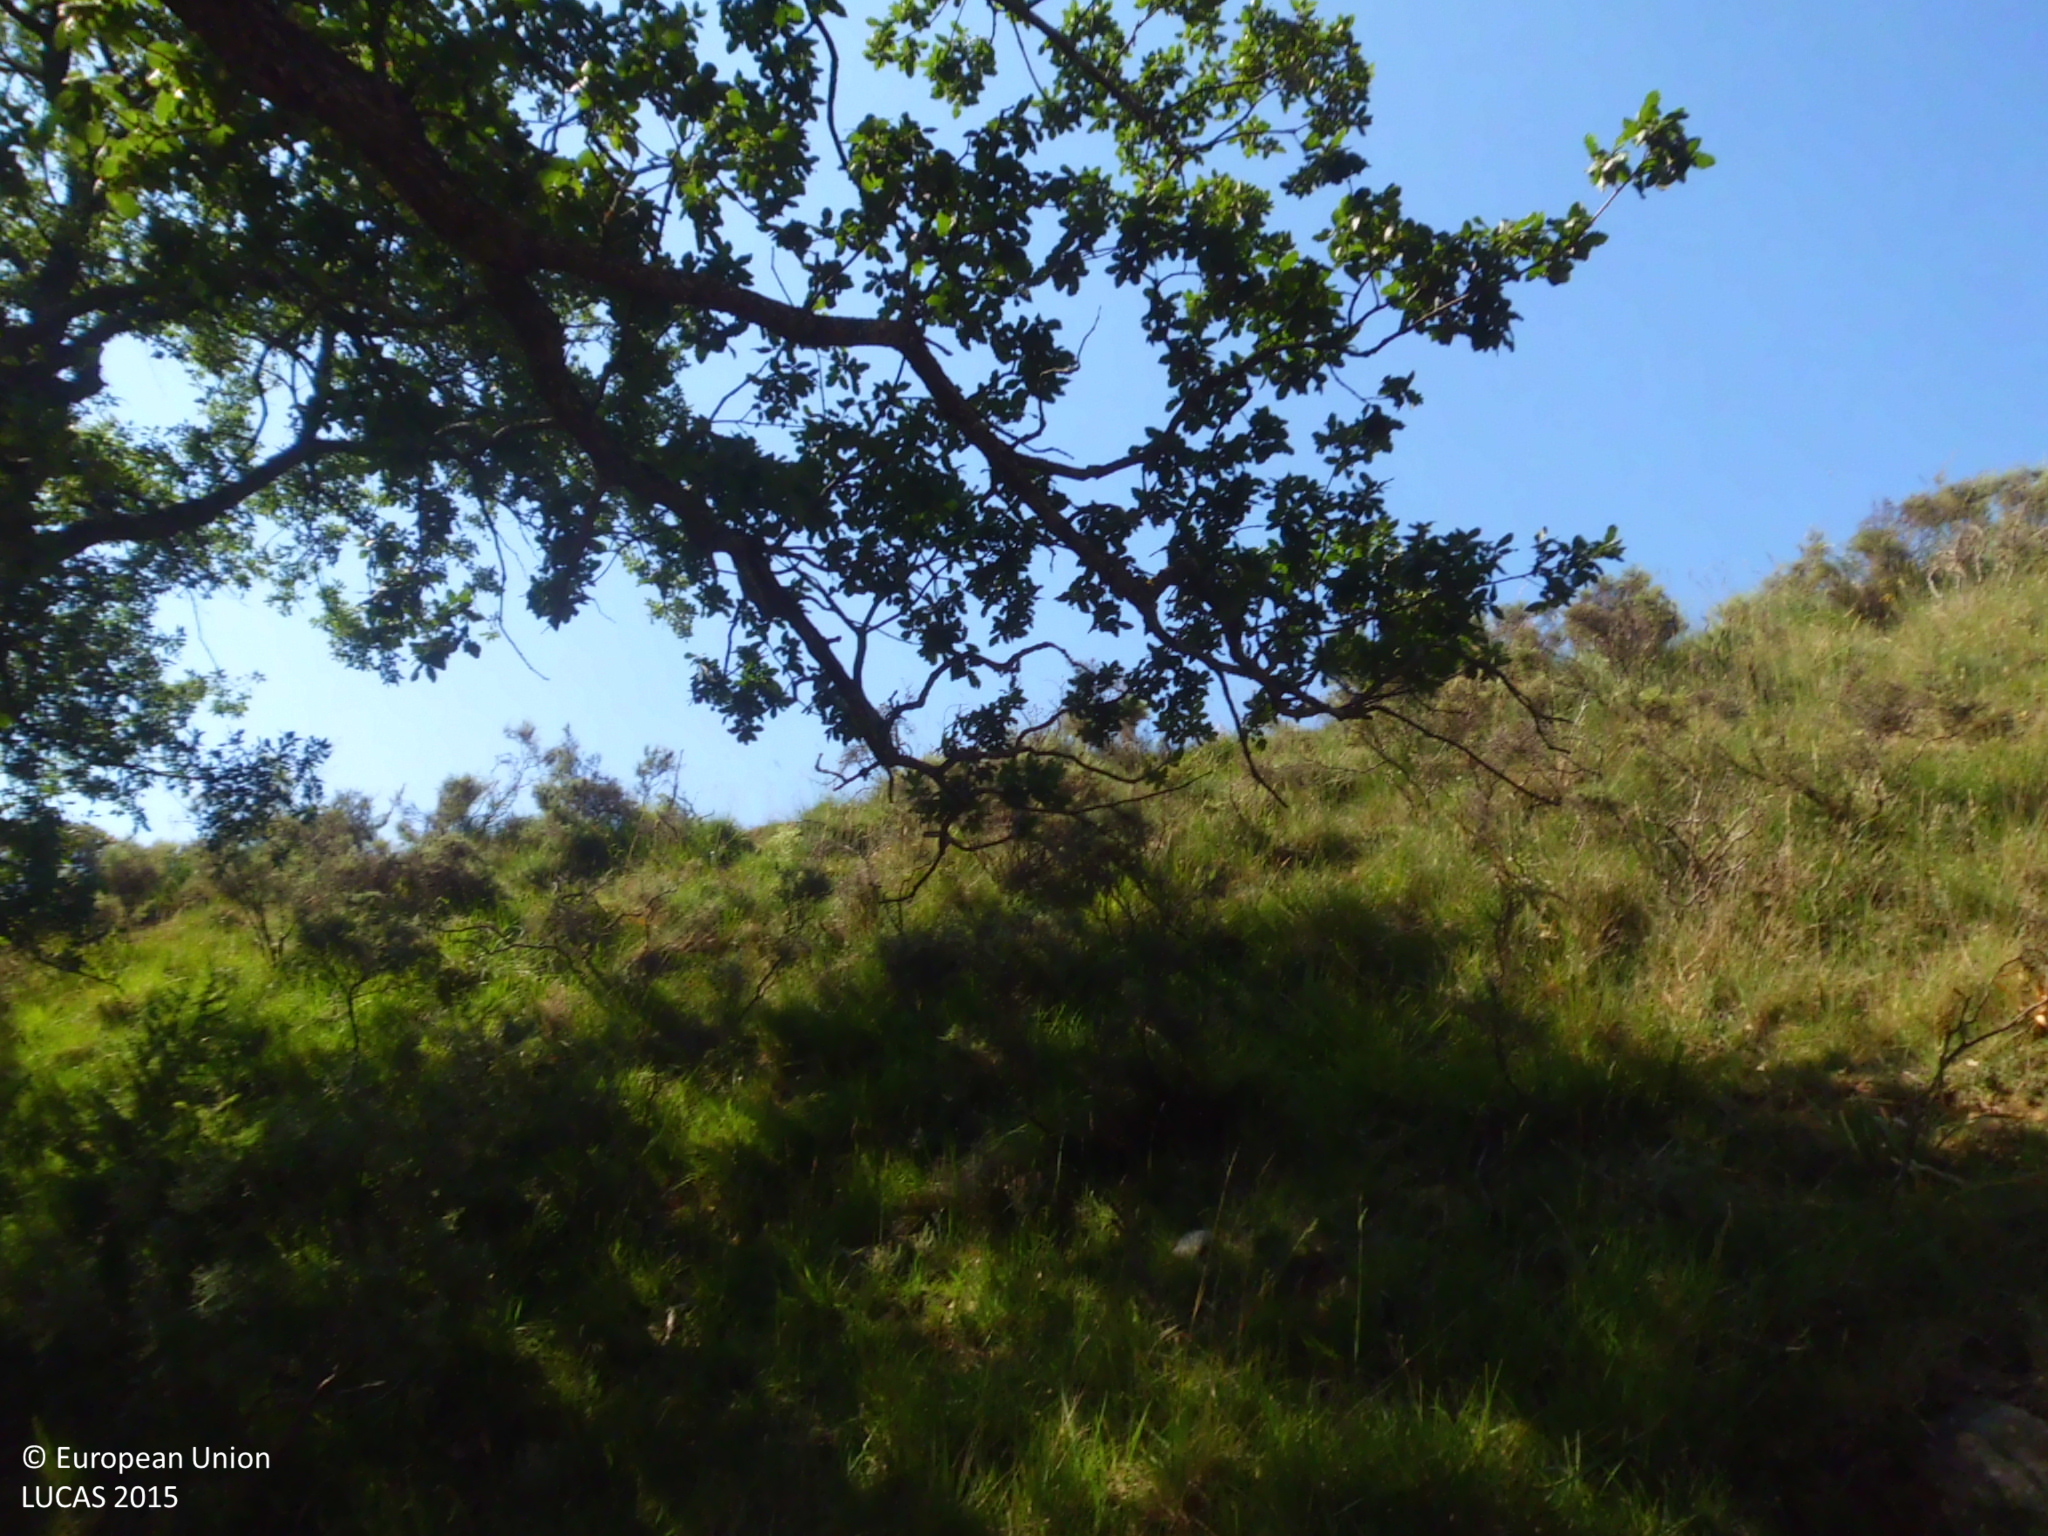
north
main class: Woodland
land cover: Broadleaved woodland
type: acidophilous oak and oak-birch forest
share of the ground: 25 - 50 %
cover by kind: unconsolidated bare surface 35 %, broadleaved forest trees 25 %, herbaceous plants 25 %, consolidated bare surface 10 %, shrubs 5 %
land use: Semi-natural and natural areas not in use
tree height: > 5 m
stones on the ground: 25 - 50 %
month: July
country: ES
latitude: 42.3314
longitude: -3.2210
